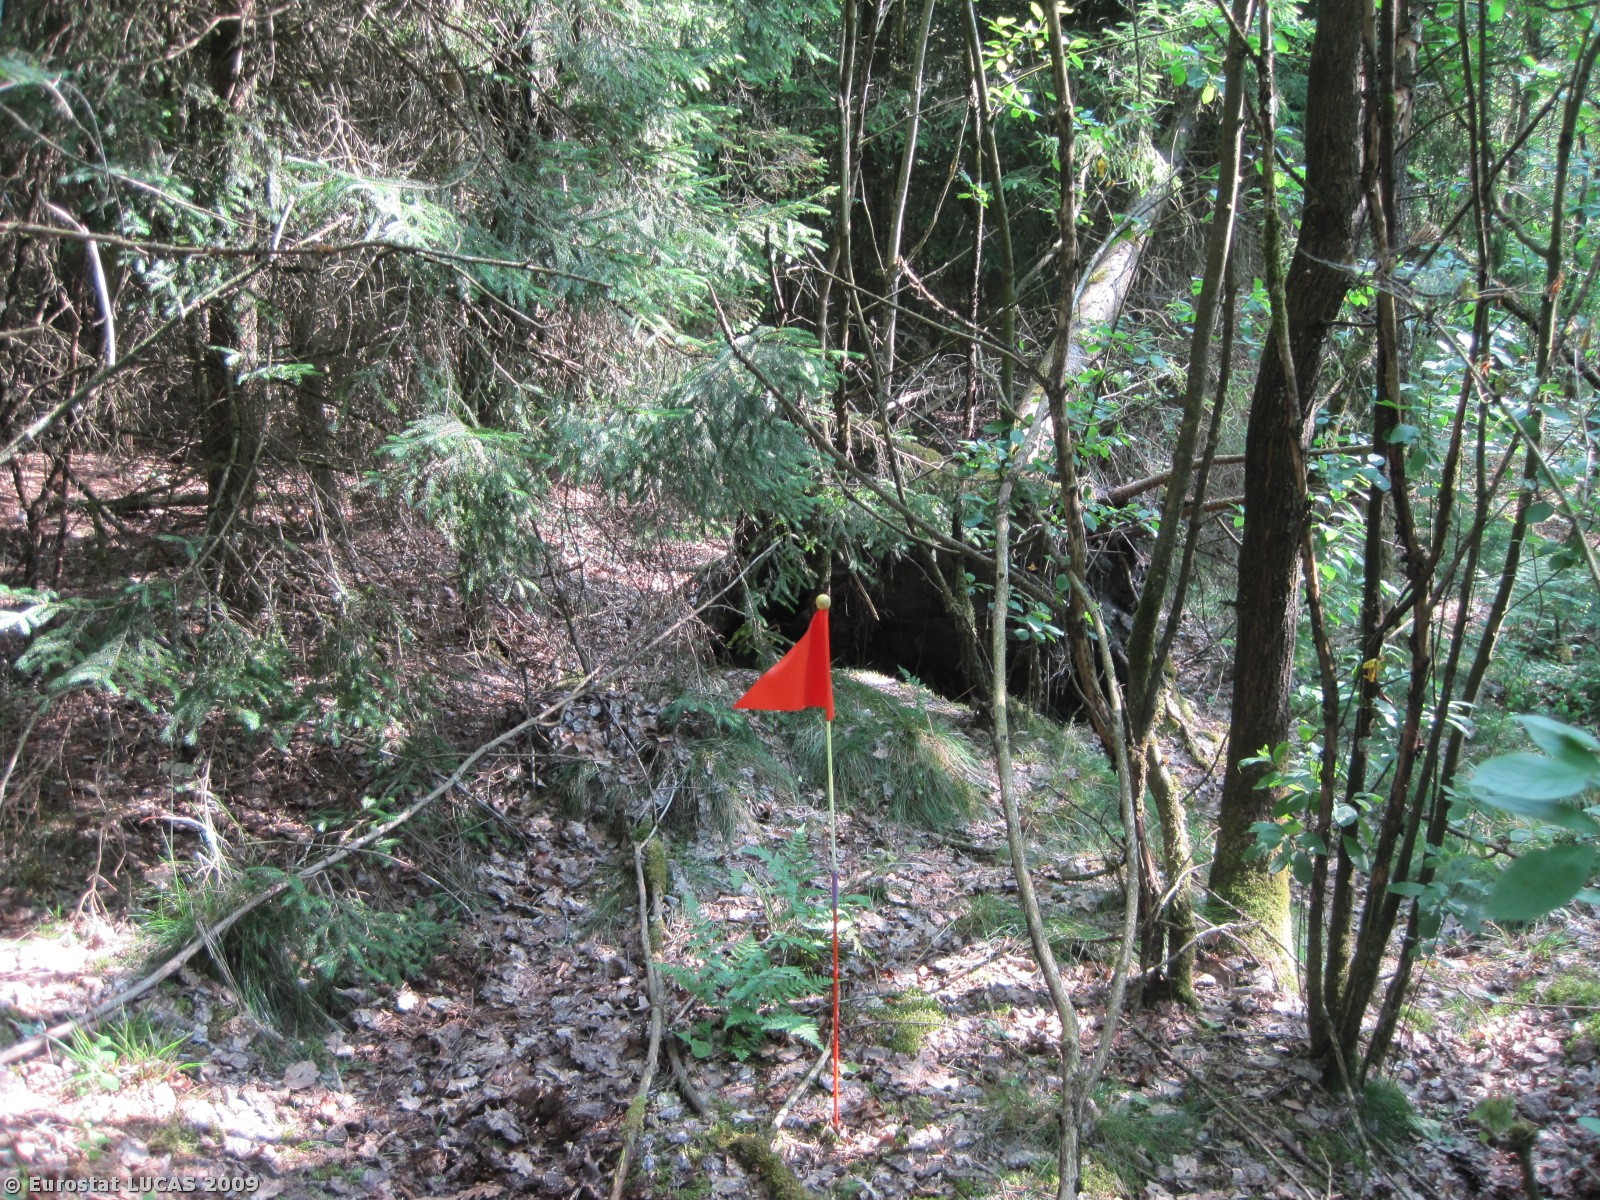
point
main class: Woodland
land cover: Mixed woodland
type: plantations and self-sown exotic forest
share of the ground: > 75 %
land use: Forestry
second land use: Amenities, museums, leisure
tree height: > 5 m
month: June
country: DK
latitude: 56.3085
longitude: 8.8537
